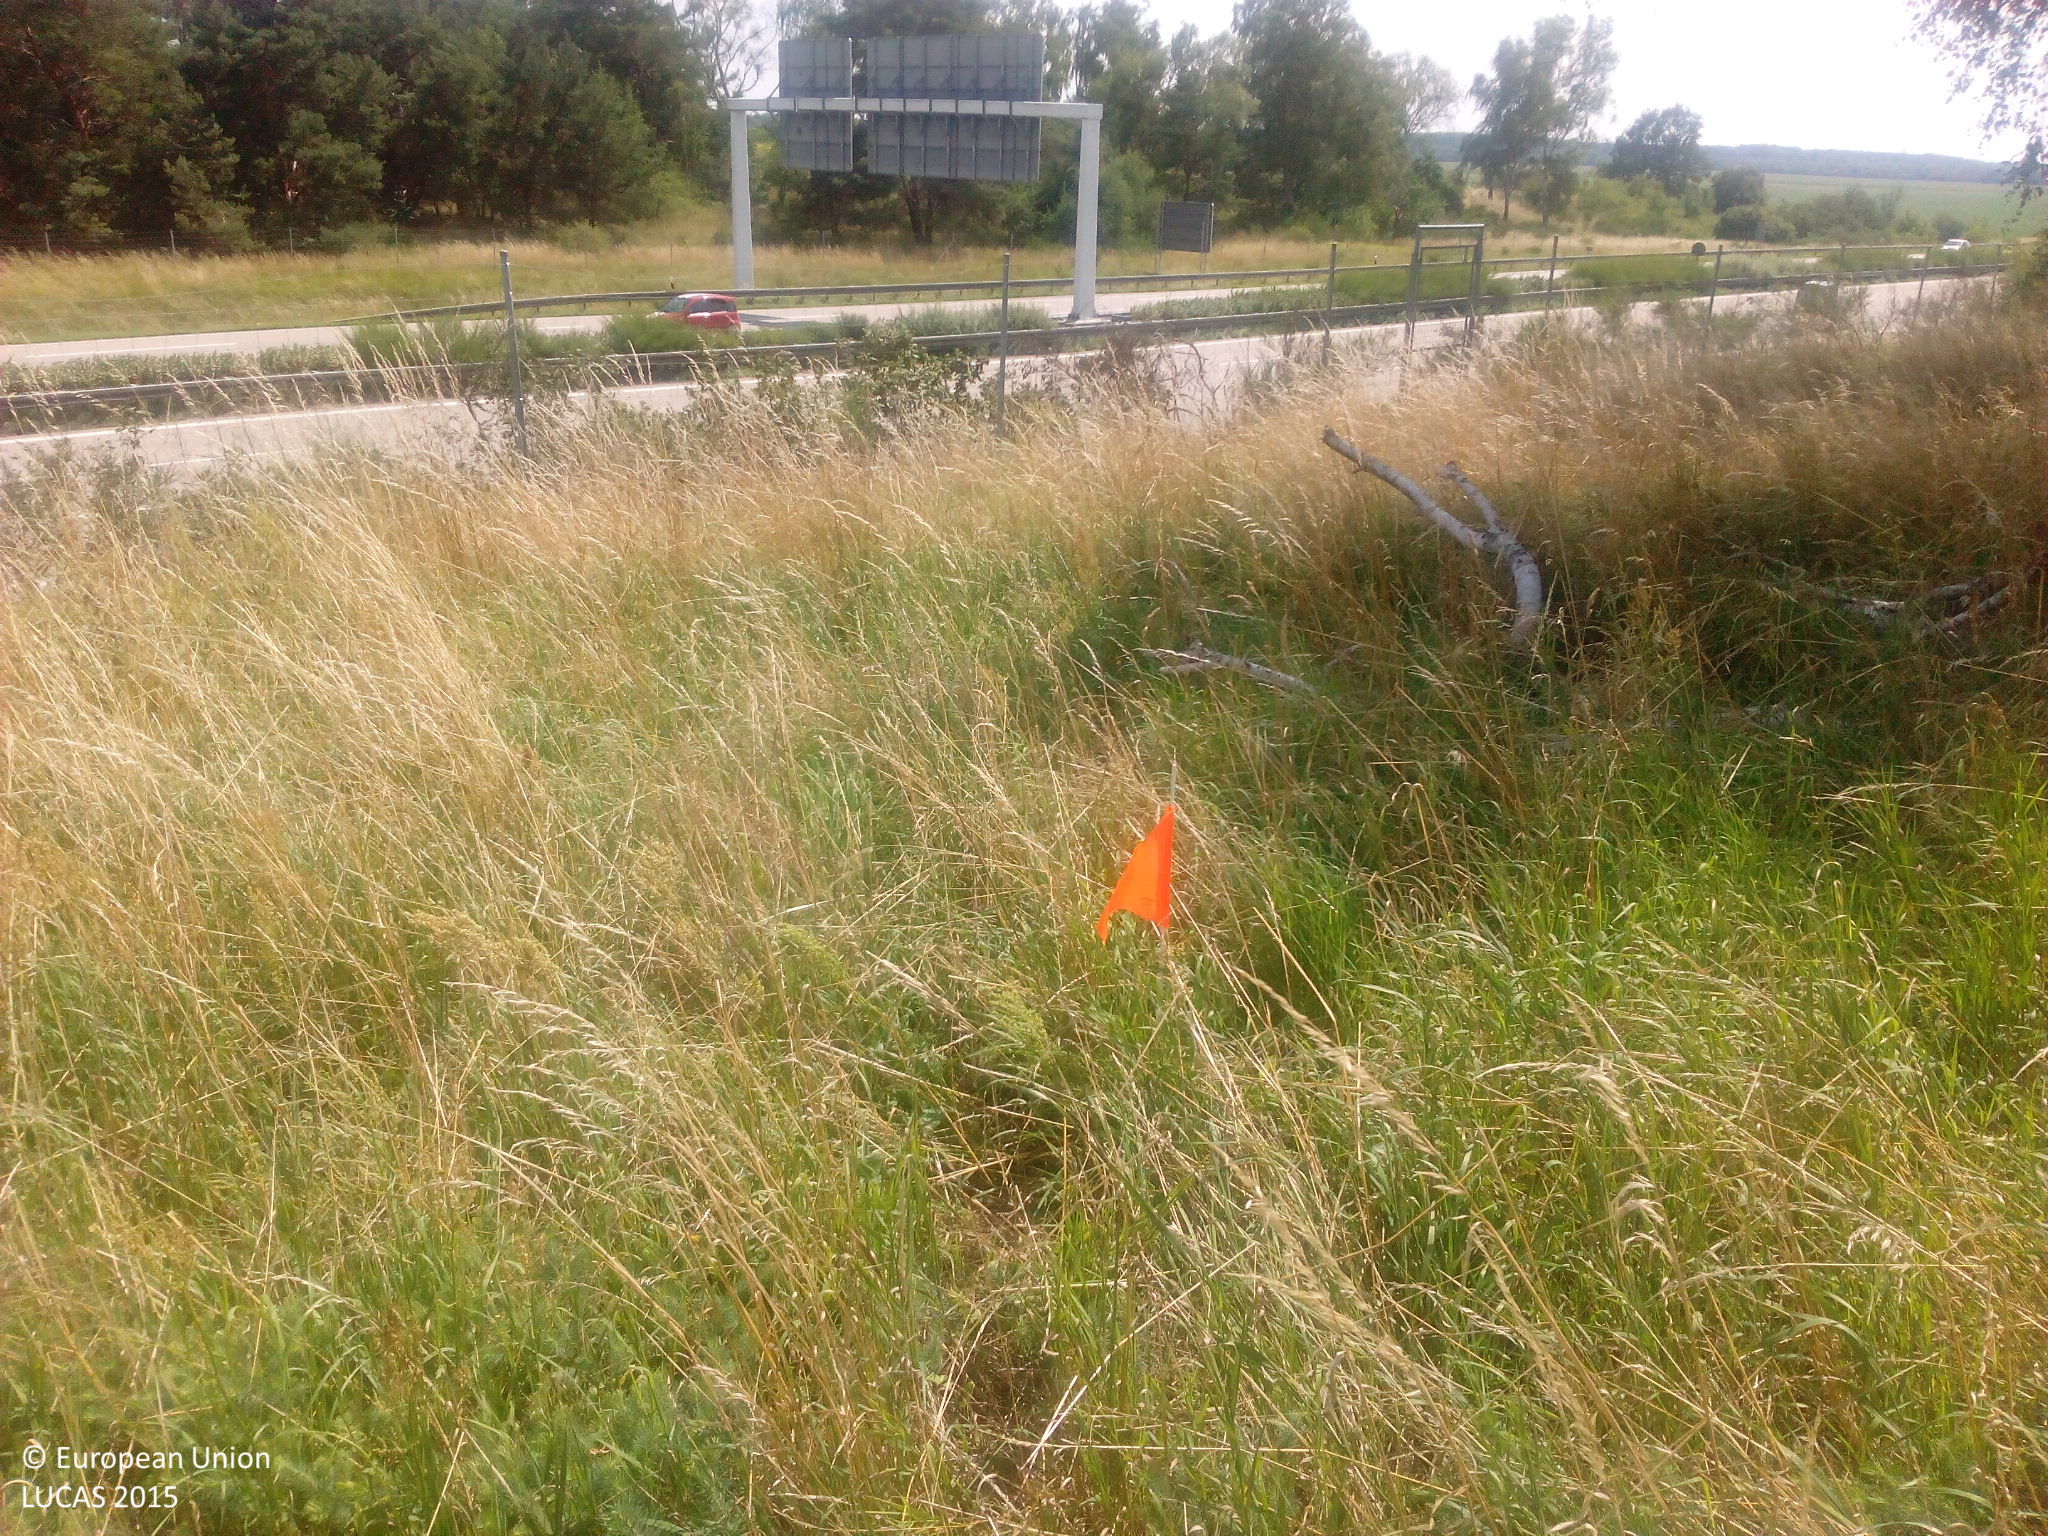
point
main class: Grassland
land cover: Grassland without tree/shrub cover
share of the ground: > 75 %
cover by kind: herbaceous plants 100 %
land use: Road transport
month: July
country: DE
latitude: 51.8858
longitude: 12.3969
